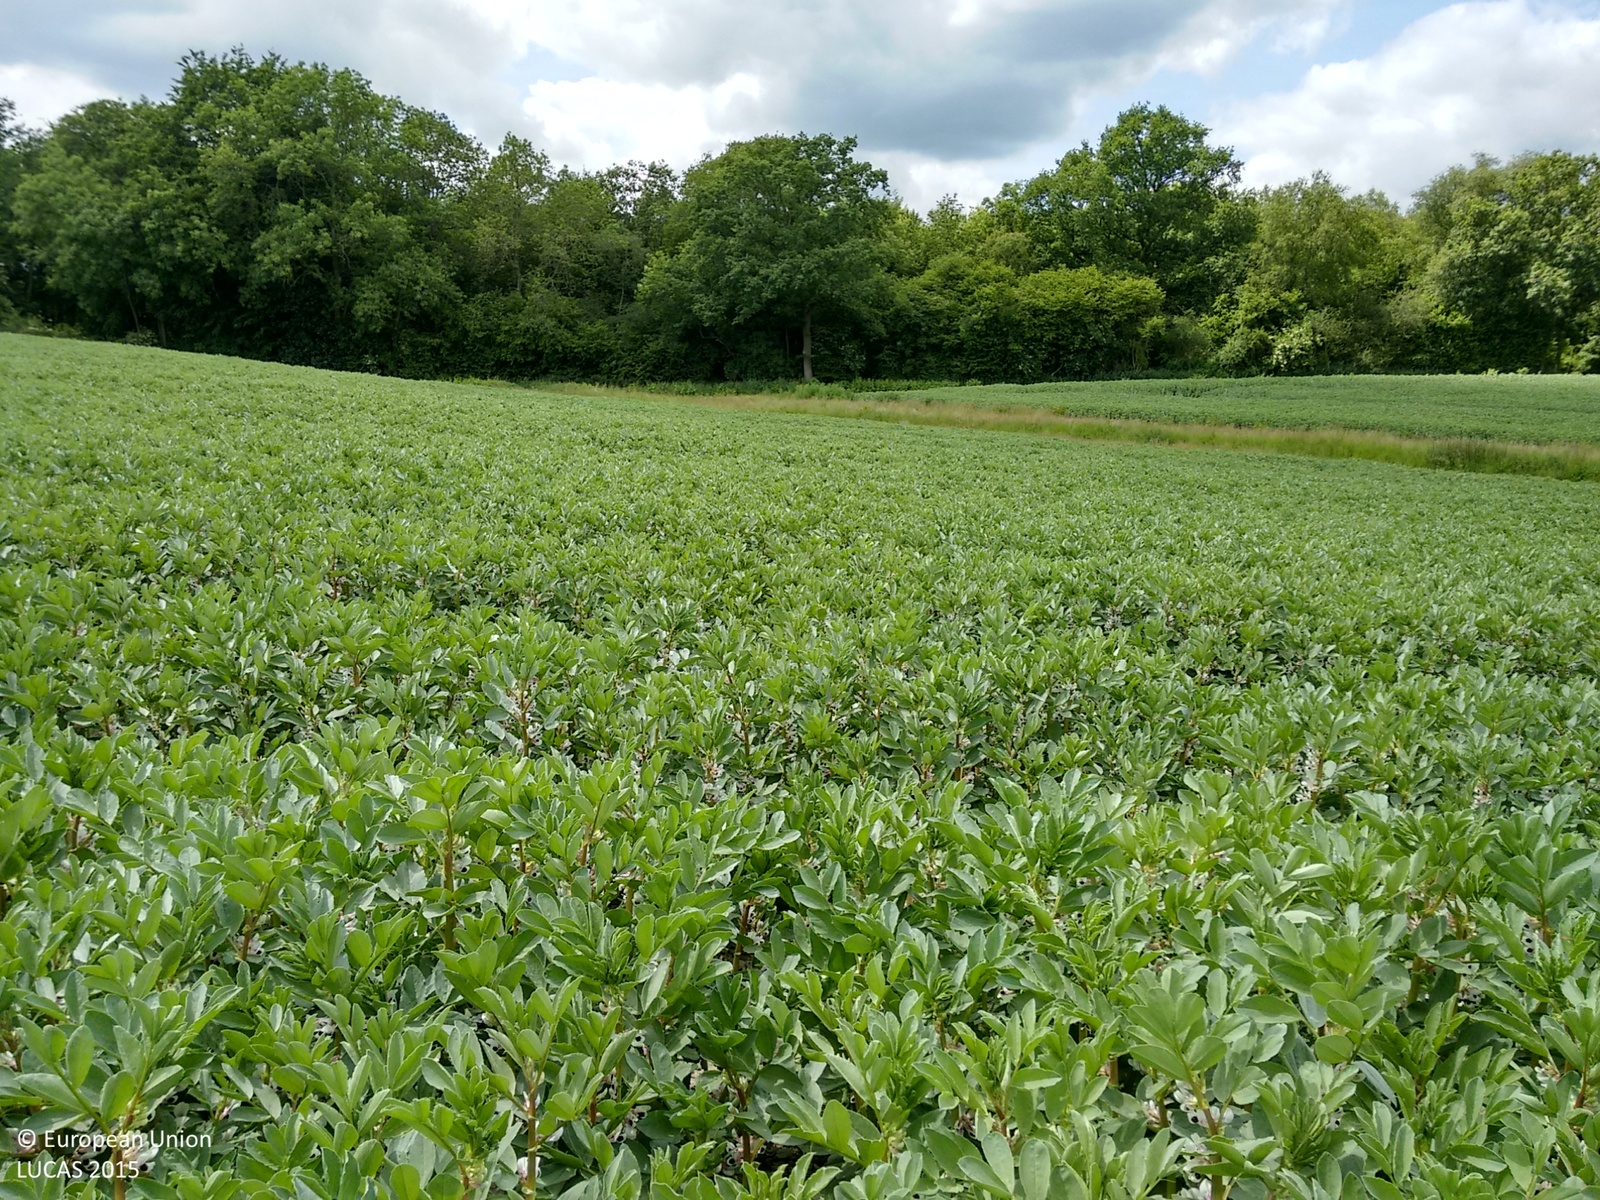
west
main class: Cropland
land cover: Dry pulses
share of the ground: > 75 %
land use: Agriculture (excluding fallow land and kitchen gardens)
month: June
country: GB
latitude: 51.3625
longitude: -1.4978
